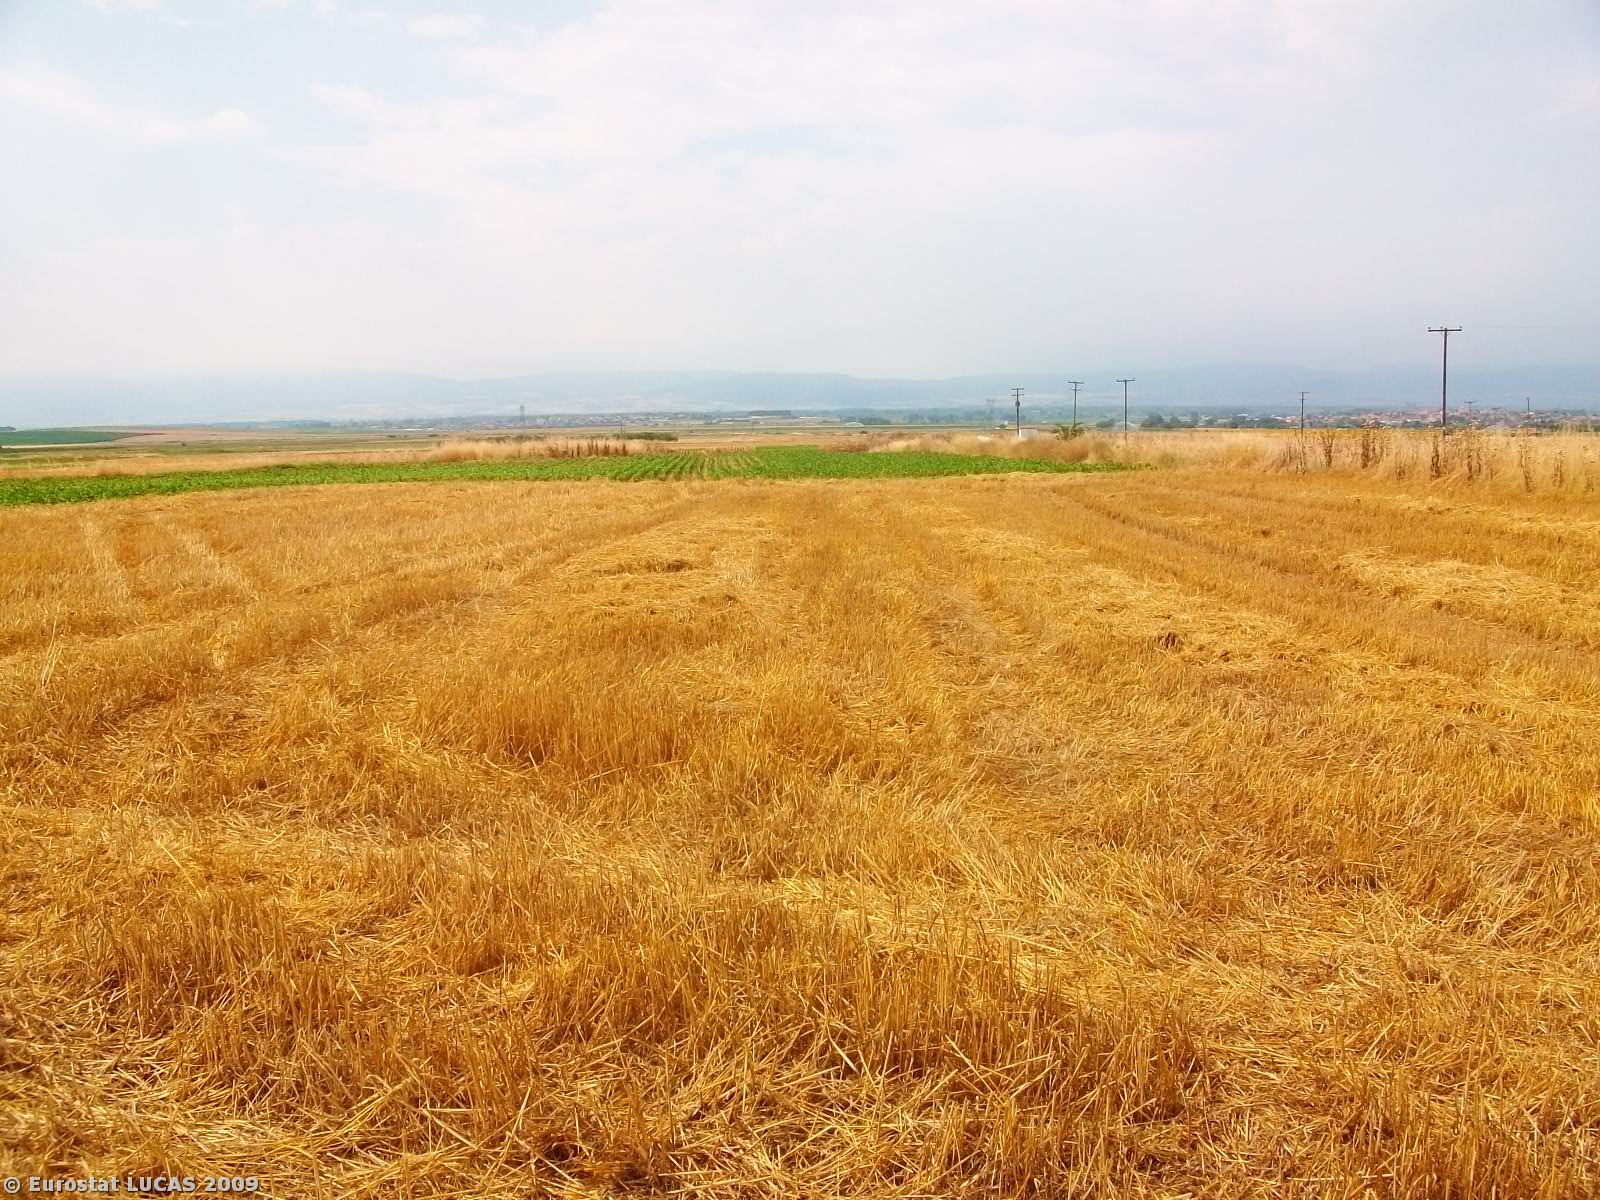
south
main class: Cropland
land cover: Durum wheat
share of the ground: > 75 %
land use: Agriculture (excluding fallow land and kitchen gardens)
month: June
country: GR
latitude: 41.0490
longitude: 23.6433
